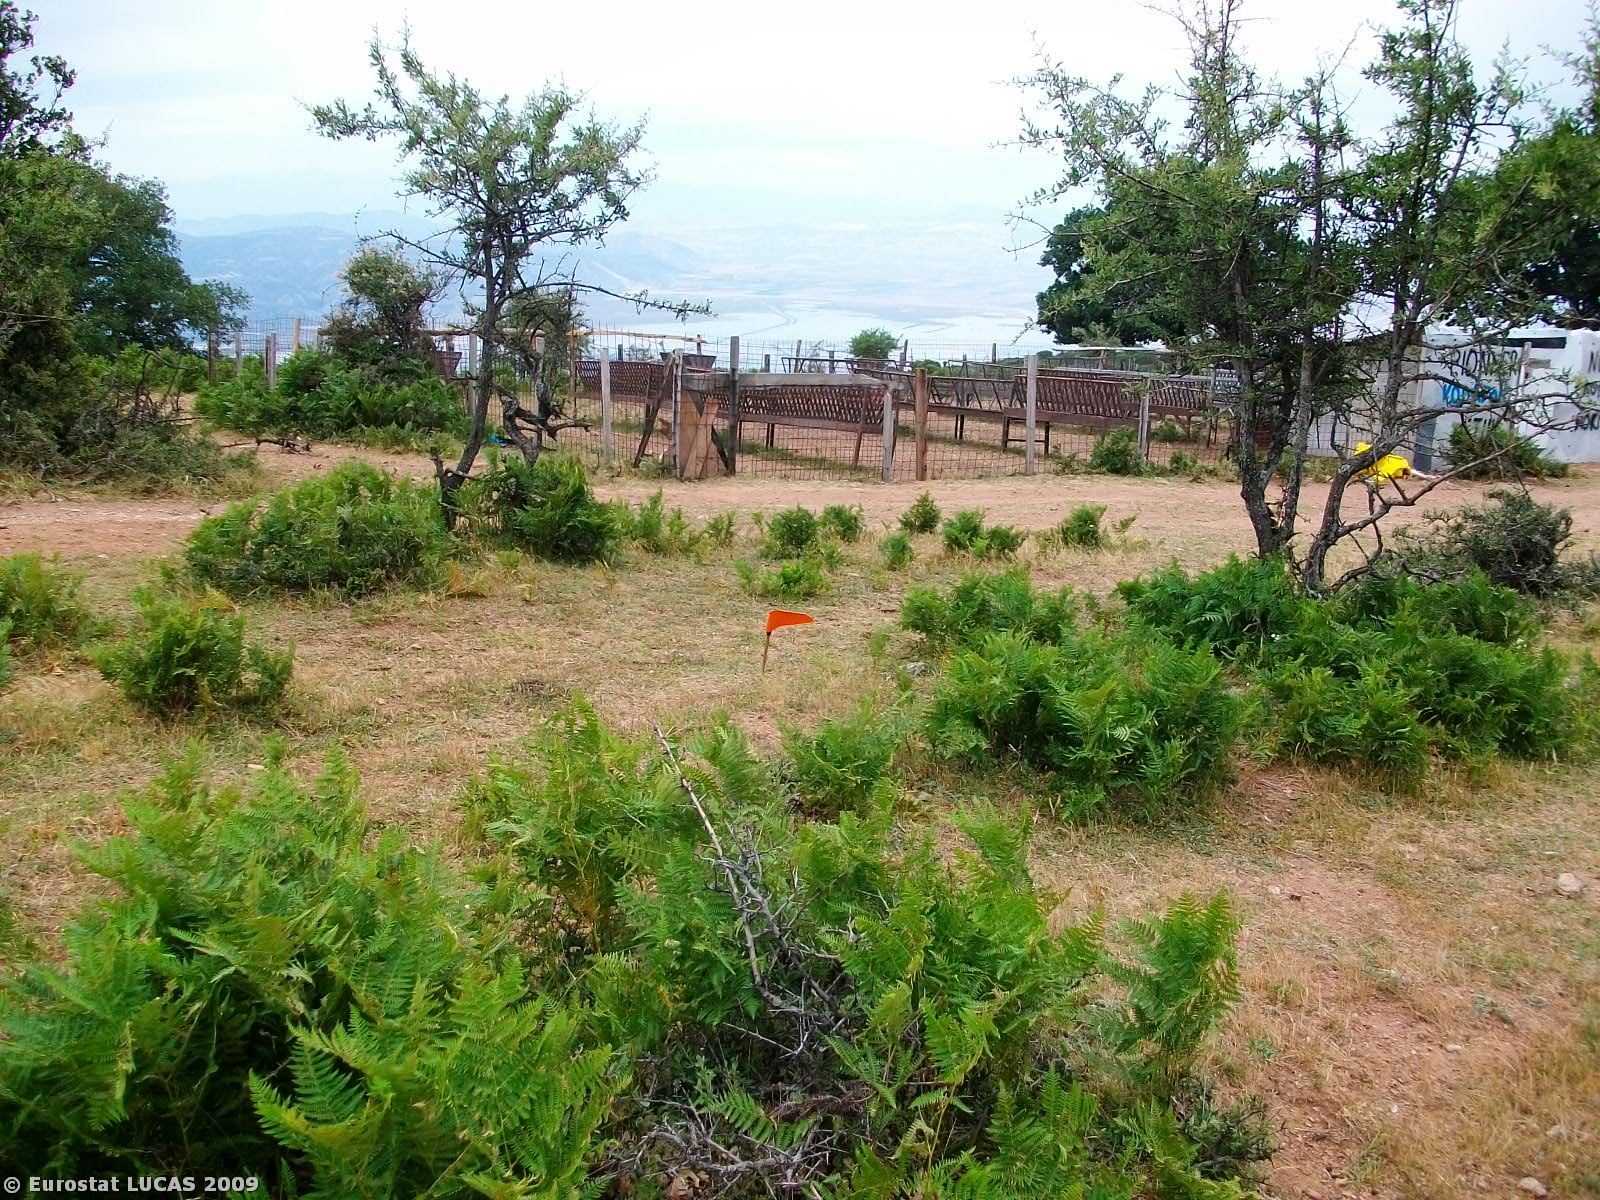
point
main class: Grassland
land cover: Grassland with sparse tree/shrub cover
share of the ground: > 75 %
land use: Agriculture (excluding fallow land and kitchen gardens)
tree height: > 5 m
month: June
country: GR
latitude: 39.5433
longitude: 22.8743
